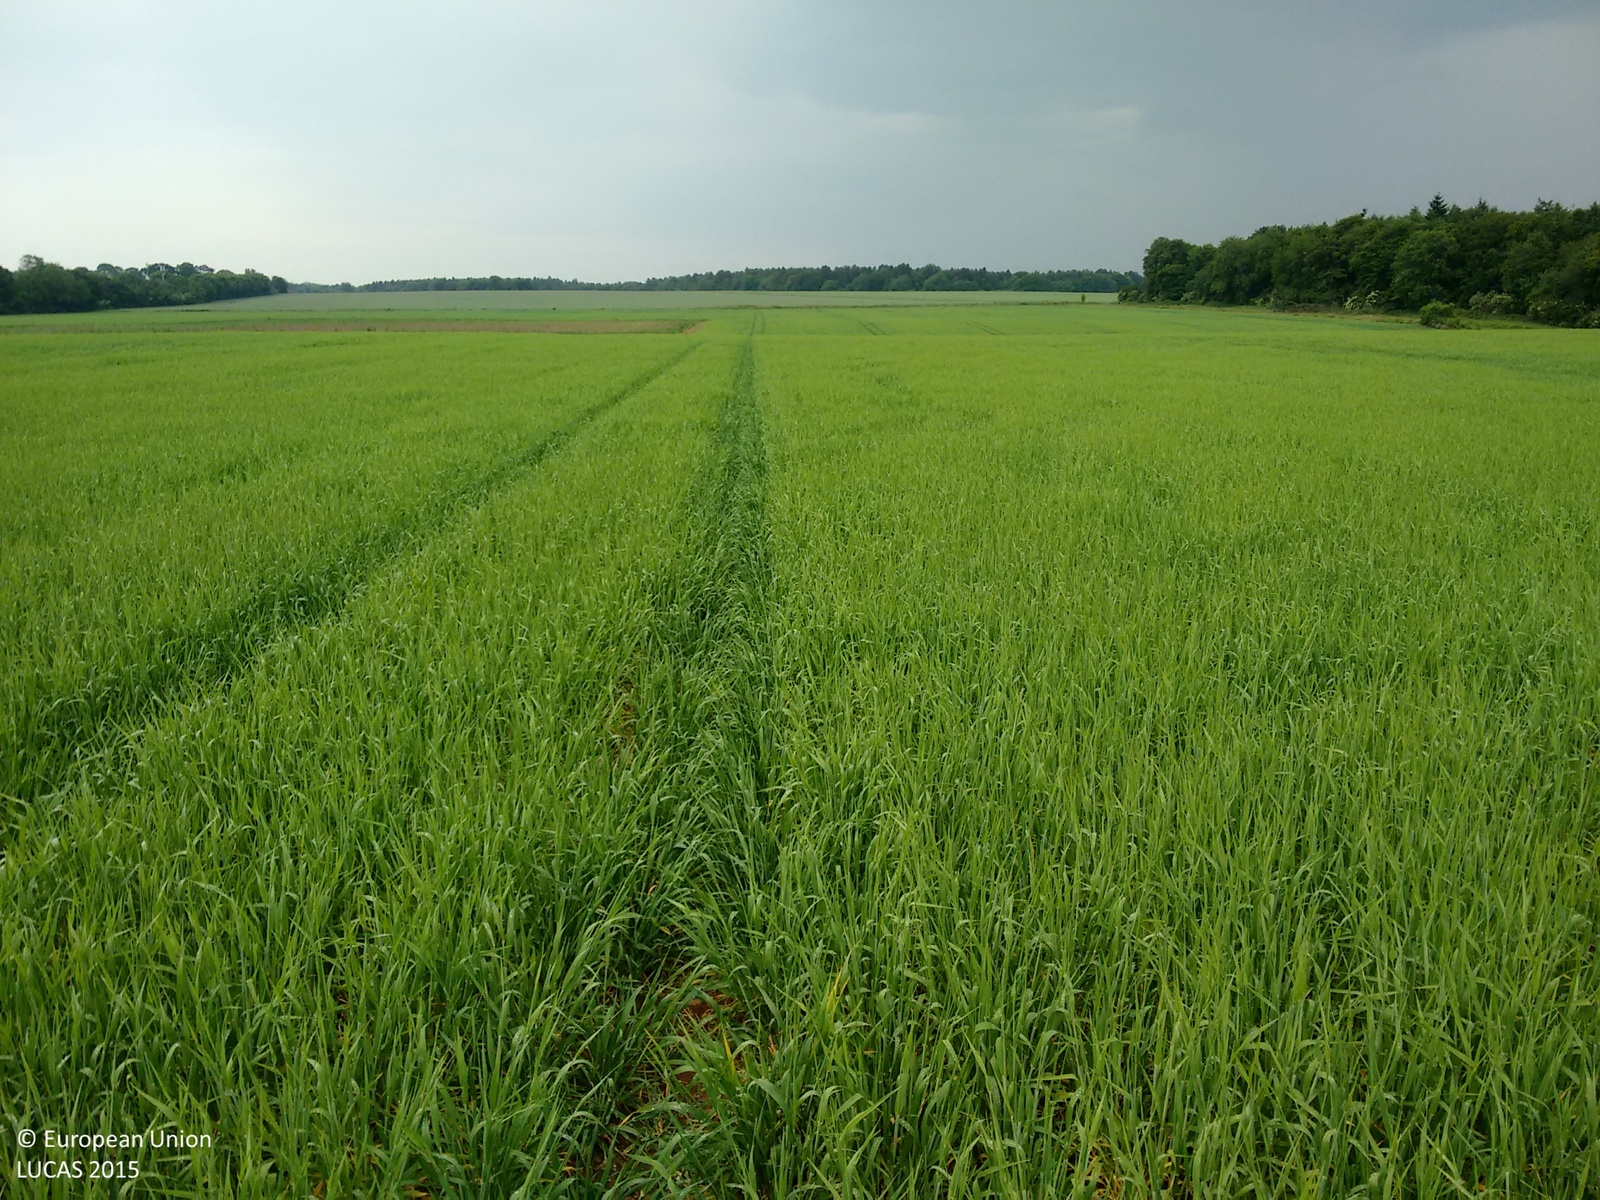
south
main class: Cropland
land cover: Barley
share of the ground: > 75 %
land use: Agriculture (excluding fallow land and kitchen gardens)
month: June
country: GB
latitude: 51.4777
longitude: -1.0601
